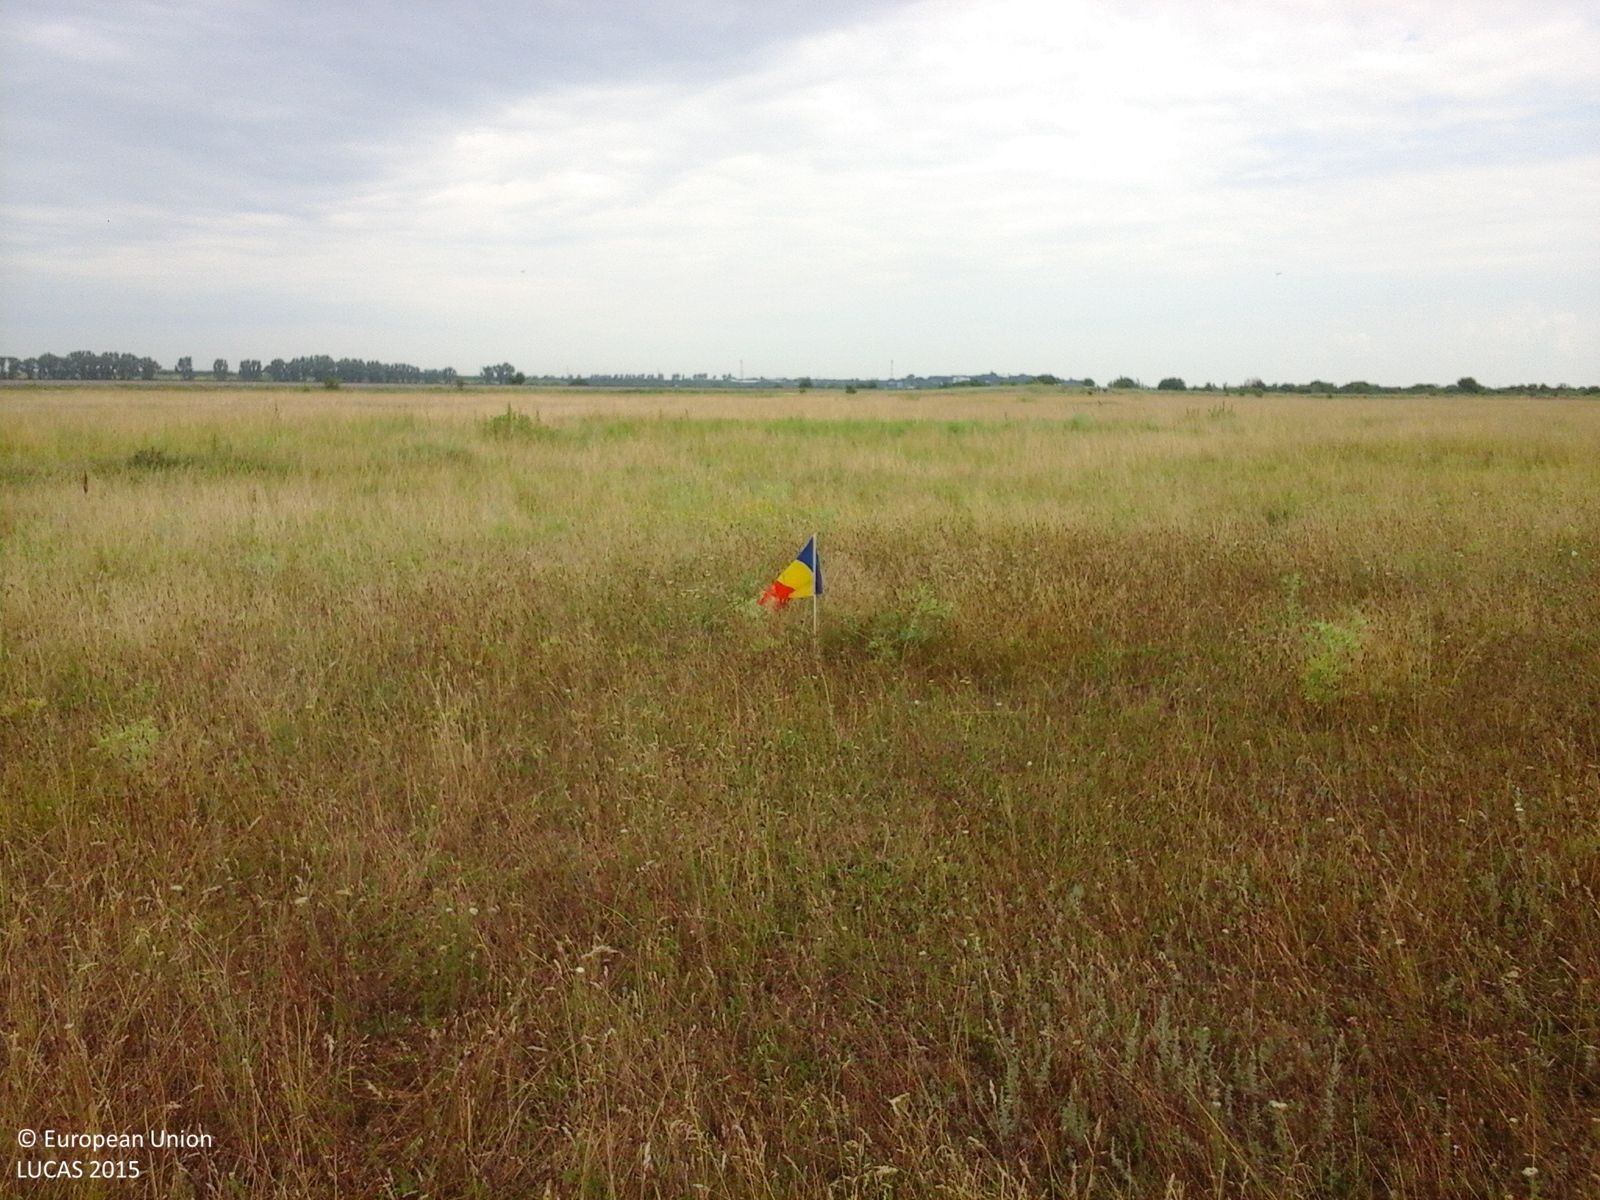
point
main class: Grassland
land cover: Grassland without tree/shrub cover
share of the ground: > 75 %
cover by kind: herbaceous plants 100 %
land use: Agriculture (excluding fallow land and kitchen gardens)
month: June
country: RO
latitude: 44.1946
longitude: 26.1566
